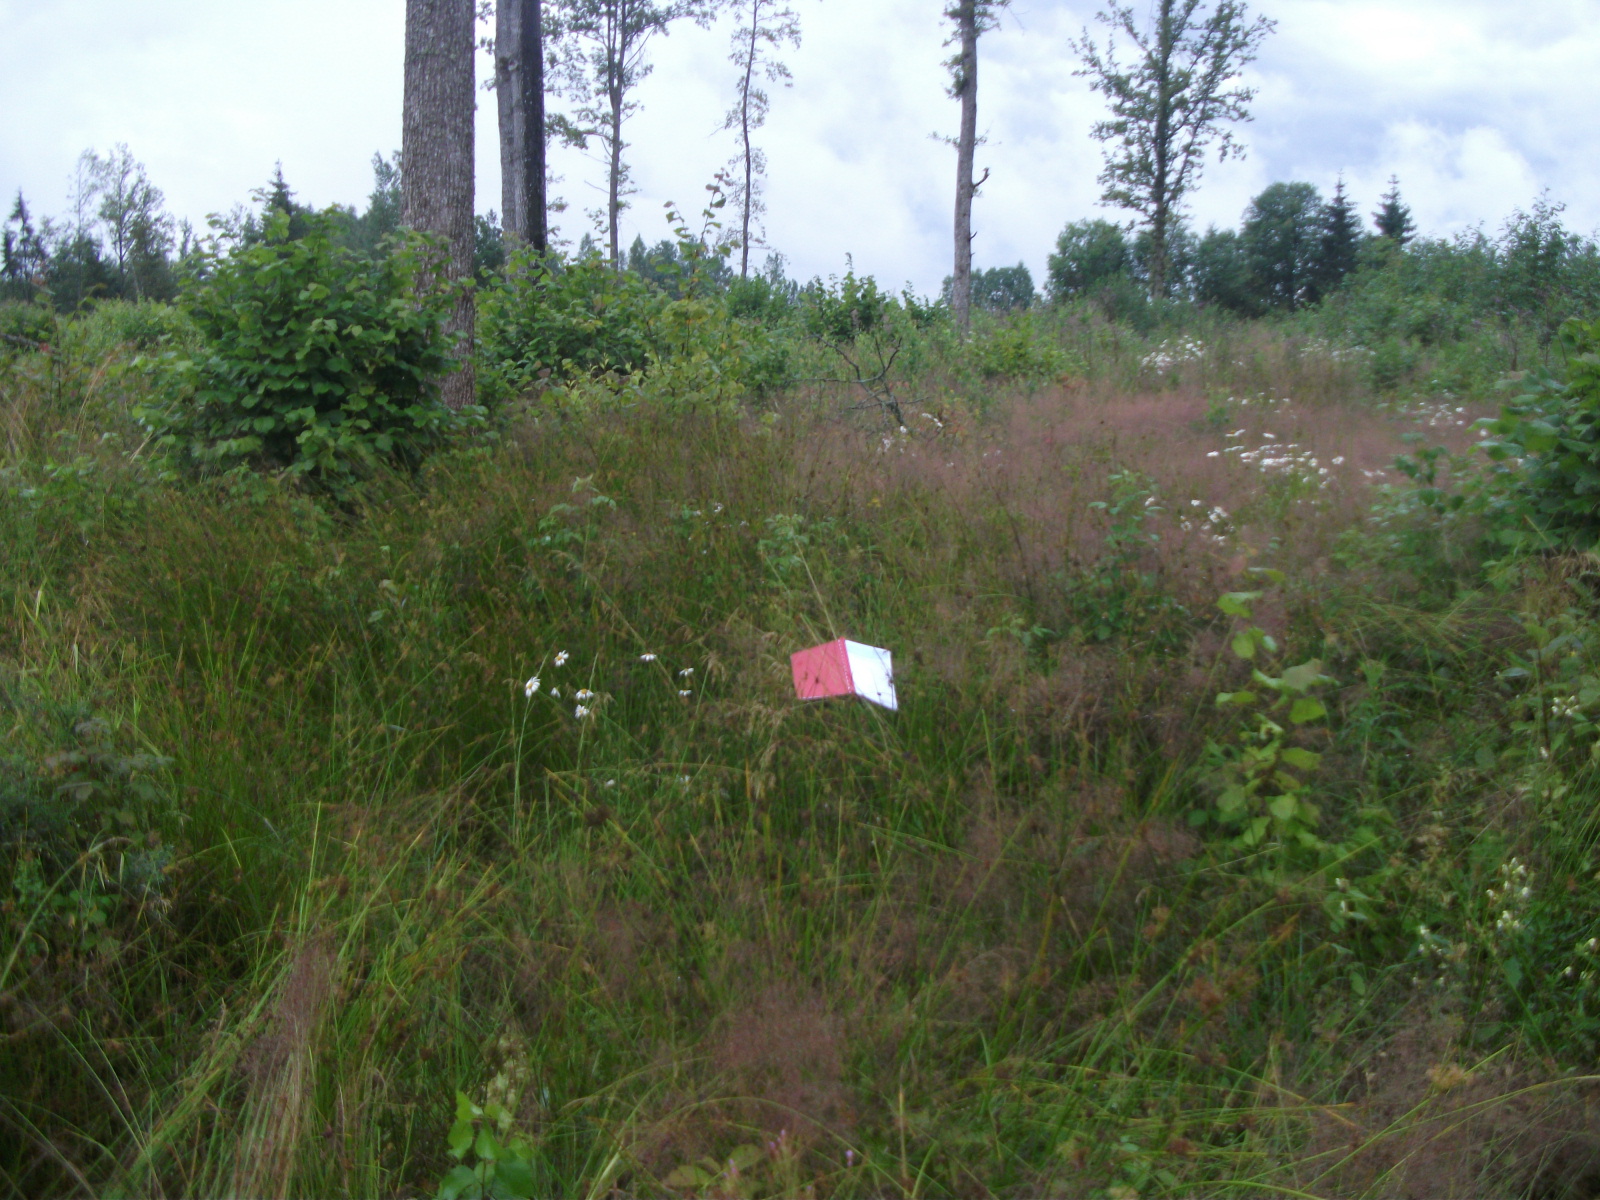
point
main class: Shrubland
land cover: Shrubland with sparse tree cover
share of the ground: > 75 %
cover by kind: shrubs 75 %, herbaceous plants 15 %, broadleaved forest trees 5 %, lichens and mosses 5 %
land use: Forestry
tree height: < 5 m
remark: Clear cut
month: July
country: LV
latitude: 56.8157
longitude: 25.8040
